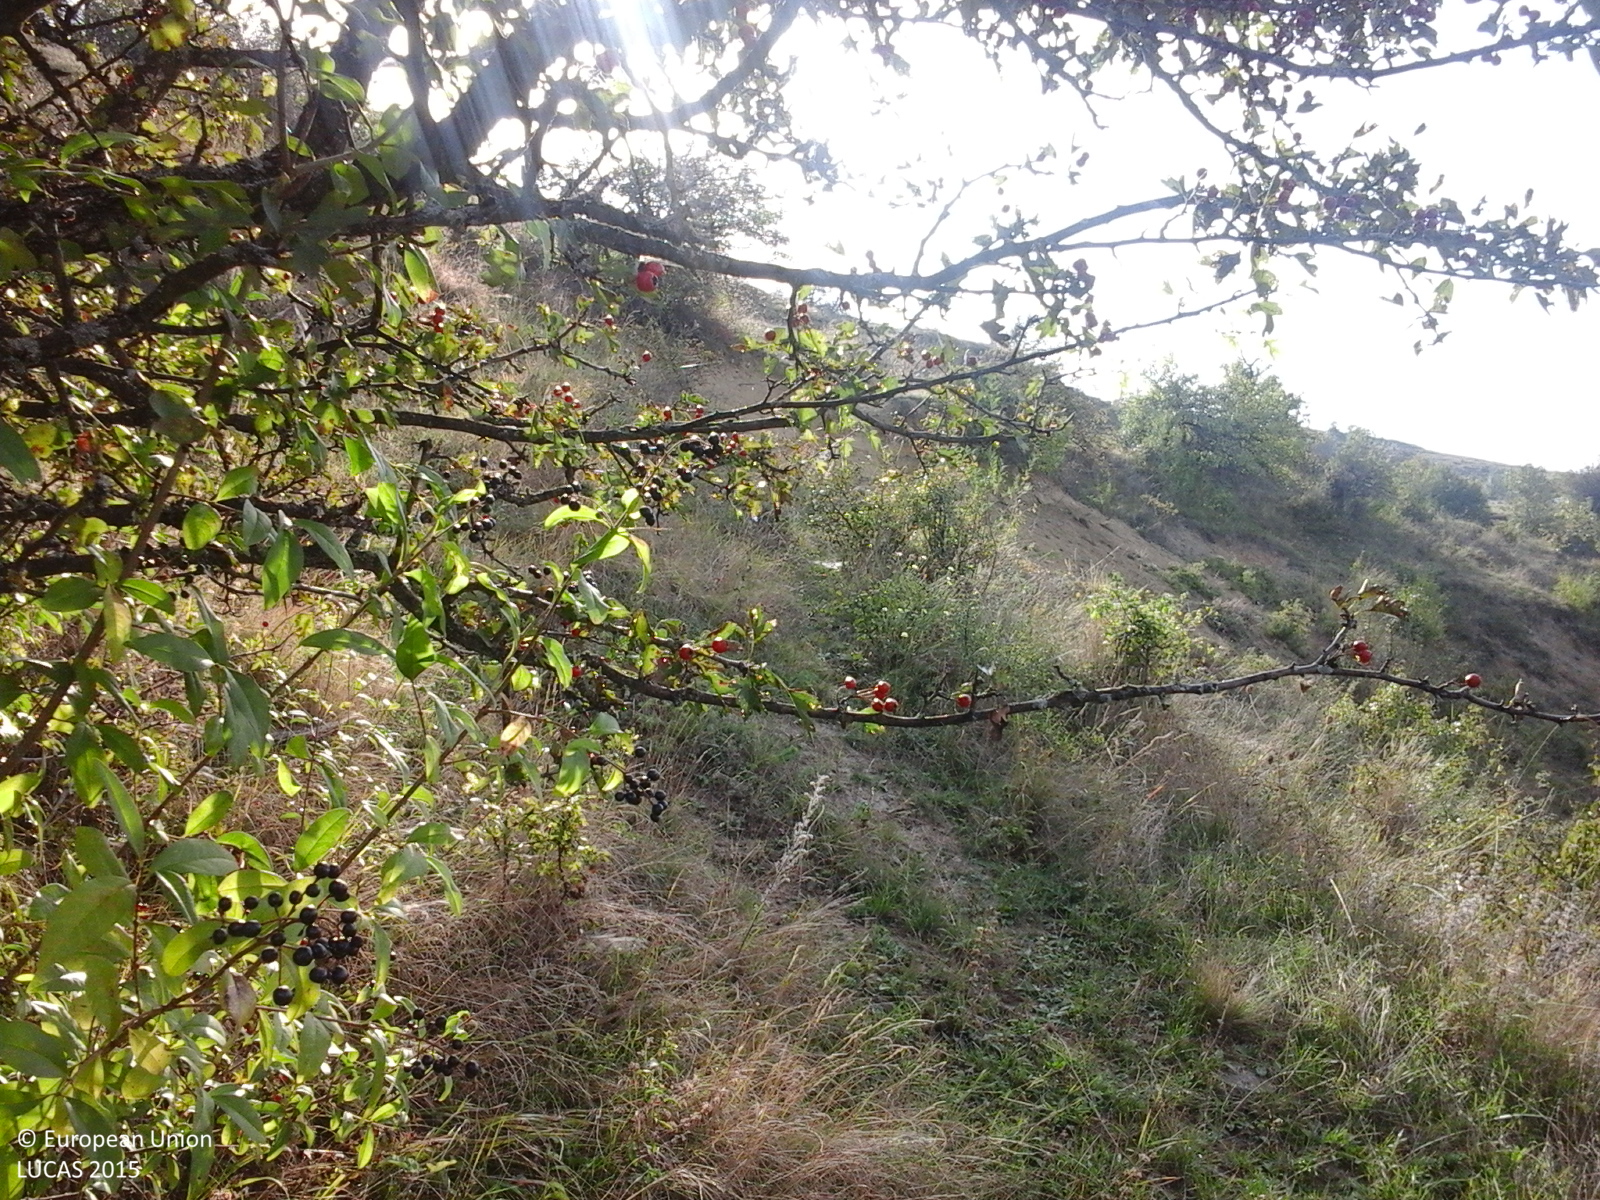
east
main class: Shrubland
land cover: Shrubland with sparse tree cover
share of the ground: > 75 %
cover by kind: herbaceous plants 85 %, shrubs 10 %, broadleaved forest trees 5 %
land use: Agriculture (excluding fallow land and kitchen gardens)
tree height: > 5 m
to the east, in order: Shrubland with sparse tree cover; Grassland with sparse tree/shrub cover; Grassland without tree/shrub cover; Grassland with sparse tree/shrub cover; Broadleaved woodland; Grassland with sparse tree/shrub cover
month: September
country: RO
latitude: 46.8593
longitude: 23.3547
